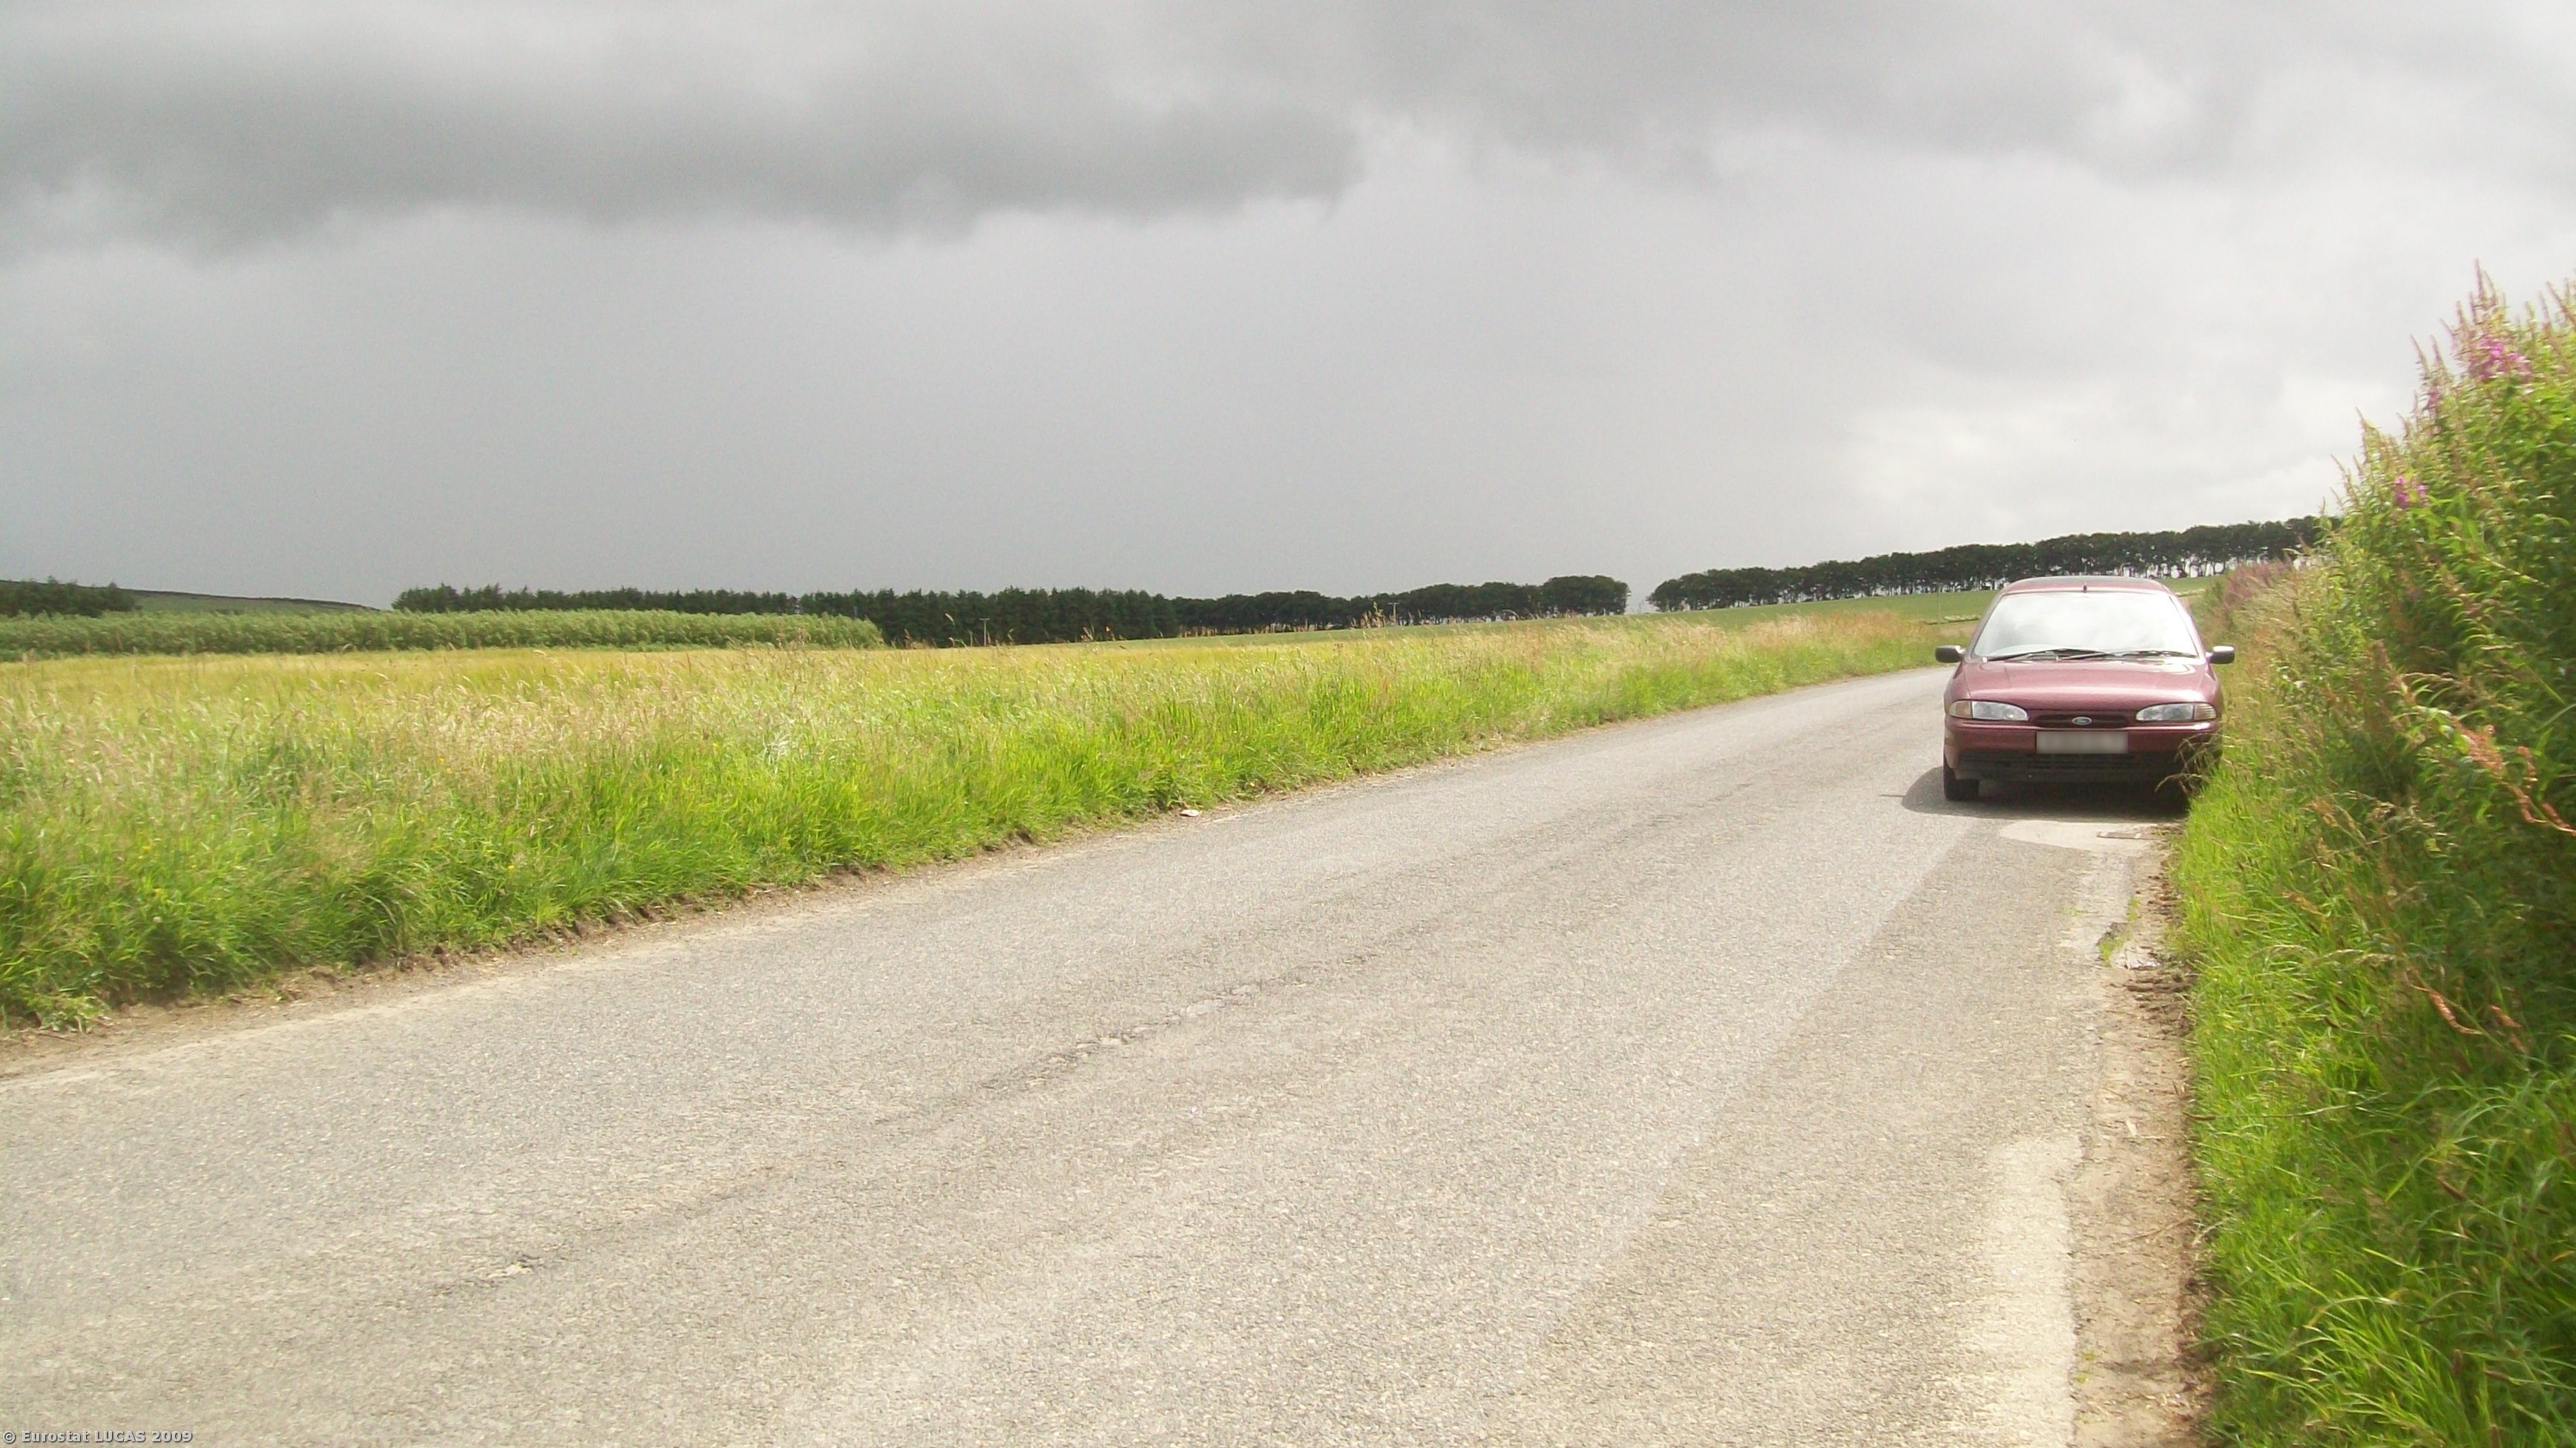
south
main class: Cropland
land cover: Barley
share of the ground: > 75 %
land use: Agriculture (excluding fallow land and kitchen gardens)
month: July
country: GB
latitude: 57.4090
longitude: -2.5551
